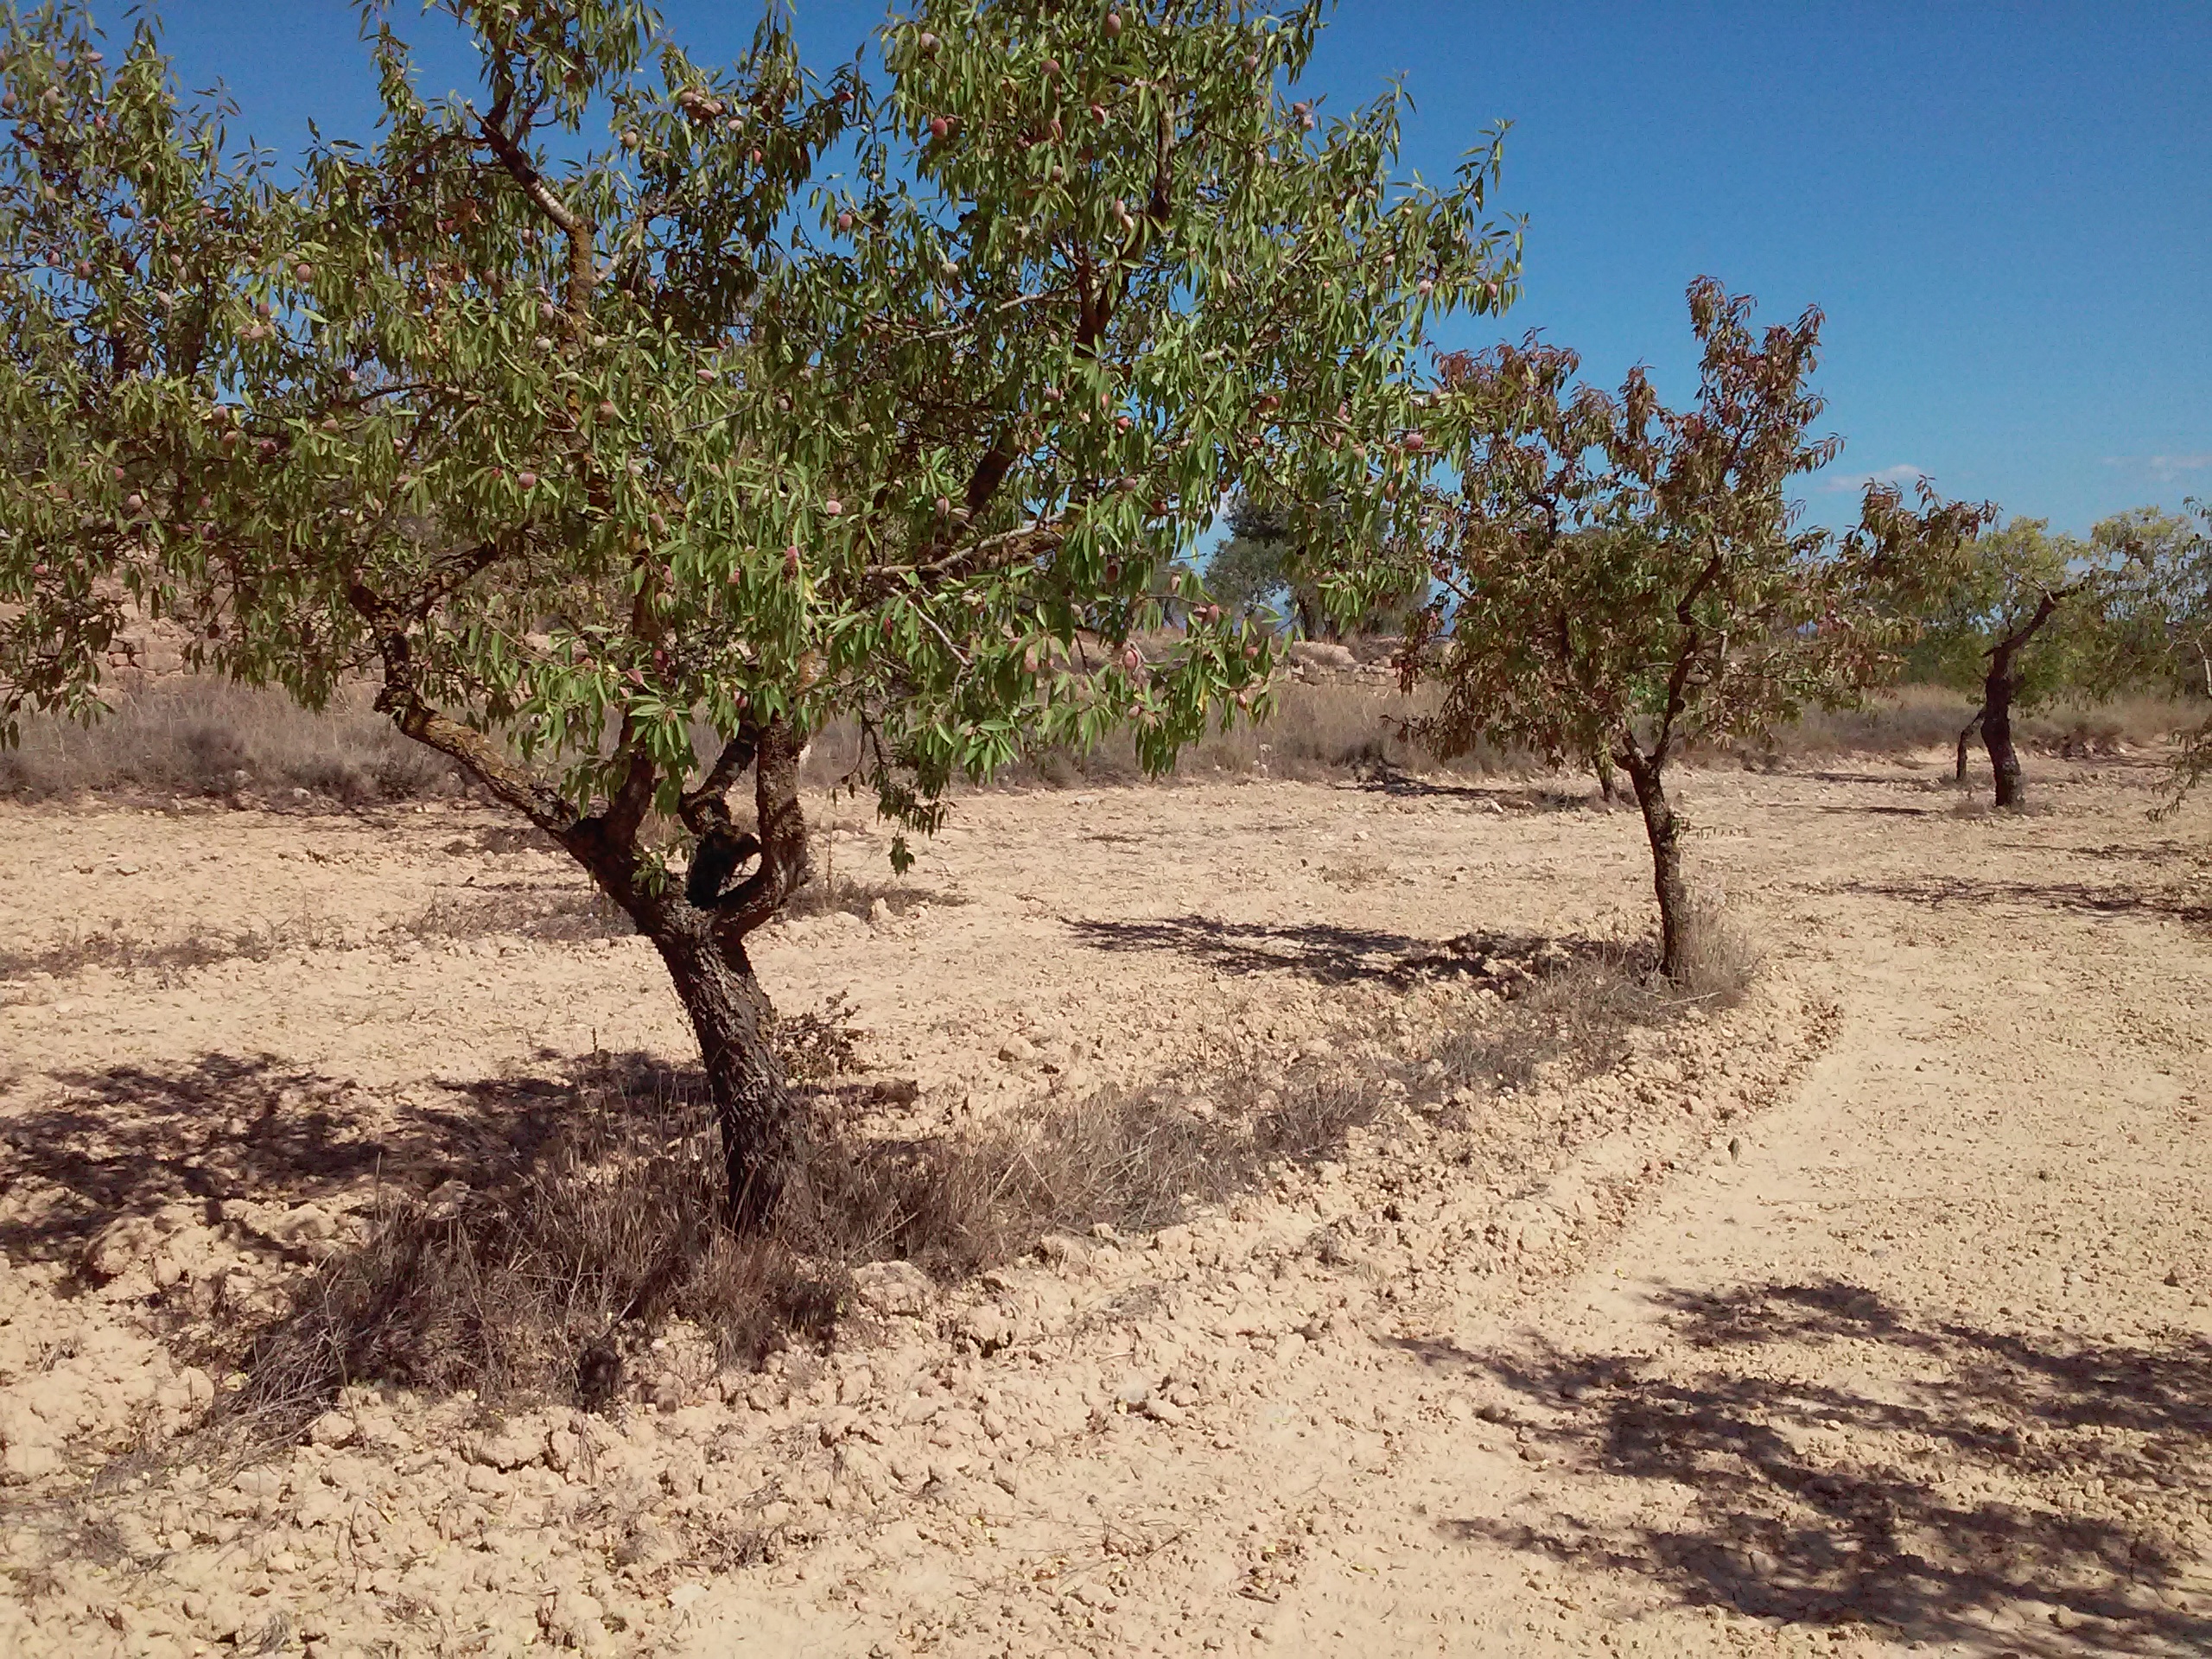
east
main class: Cropland
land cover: Nuts trees
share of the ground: 25 - 50 %
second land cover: Other bare soil
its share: > 75 %
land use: Agriculture (excluding fallow land and kitchen gardens)
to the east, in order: Nuts trees; Other bare soil; Tracks; Grass margins; Dry stone walls; Olive groves; Dry stone walls; Olive groves; Dry stone walls; Olive groves; Dry stone walls; Olive groves; Dry stone walls; Olive groves; Dry stone walls; Olive groves; Dry stone walls; Olive groves; Dry stone walls; Olive groves; Dry stone walls
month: August
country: ES
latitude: 41.3532
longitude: 0.5109
